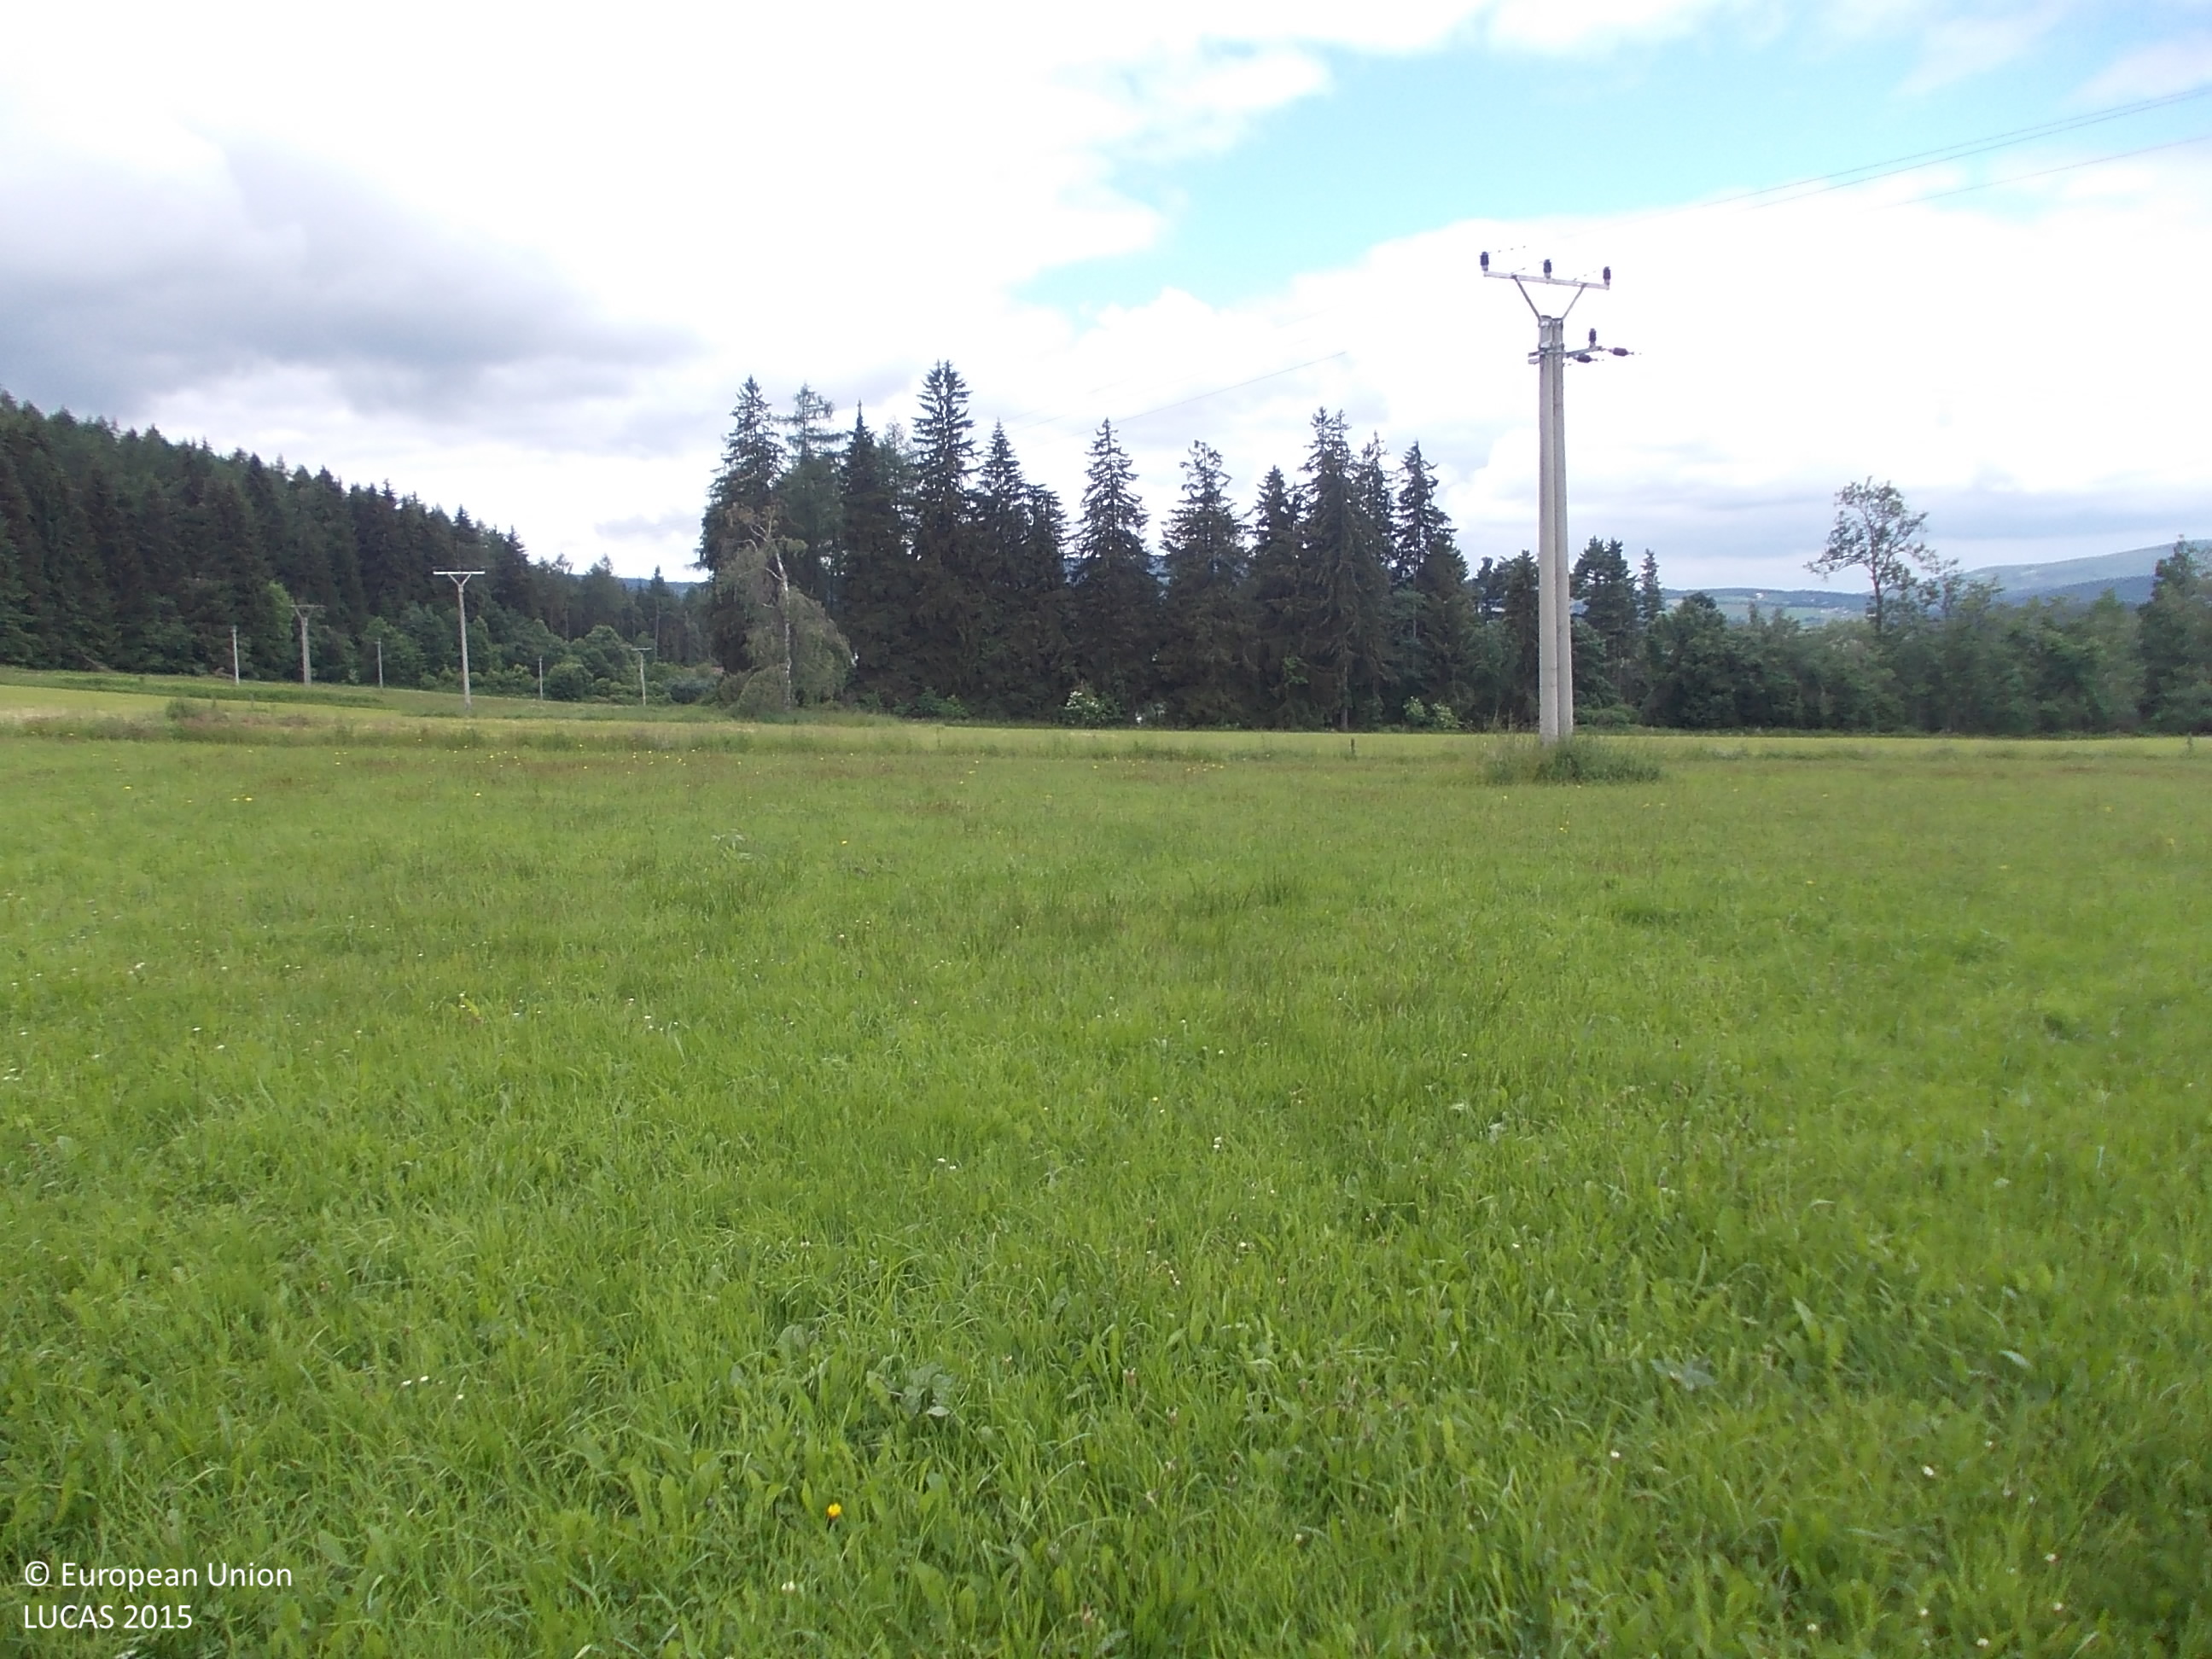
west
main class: Grassland
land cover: Grassland without tree/shrub cover
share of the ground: > 75 %
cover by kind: herbaceous plants 100 %
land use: Agriculture (excluding fallow land and kitchen gardens)
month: June
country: CZ
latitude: 49.0797
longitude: 13.7103
